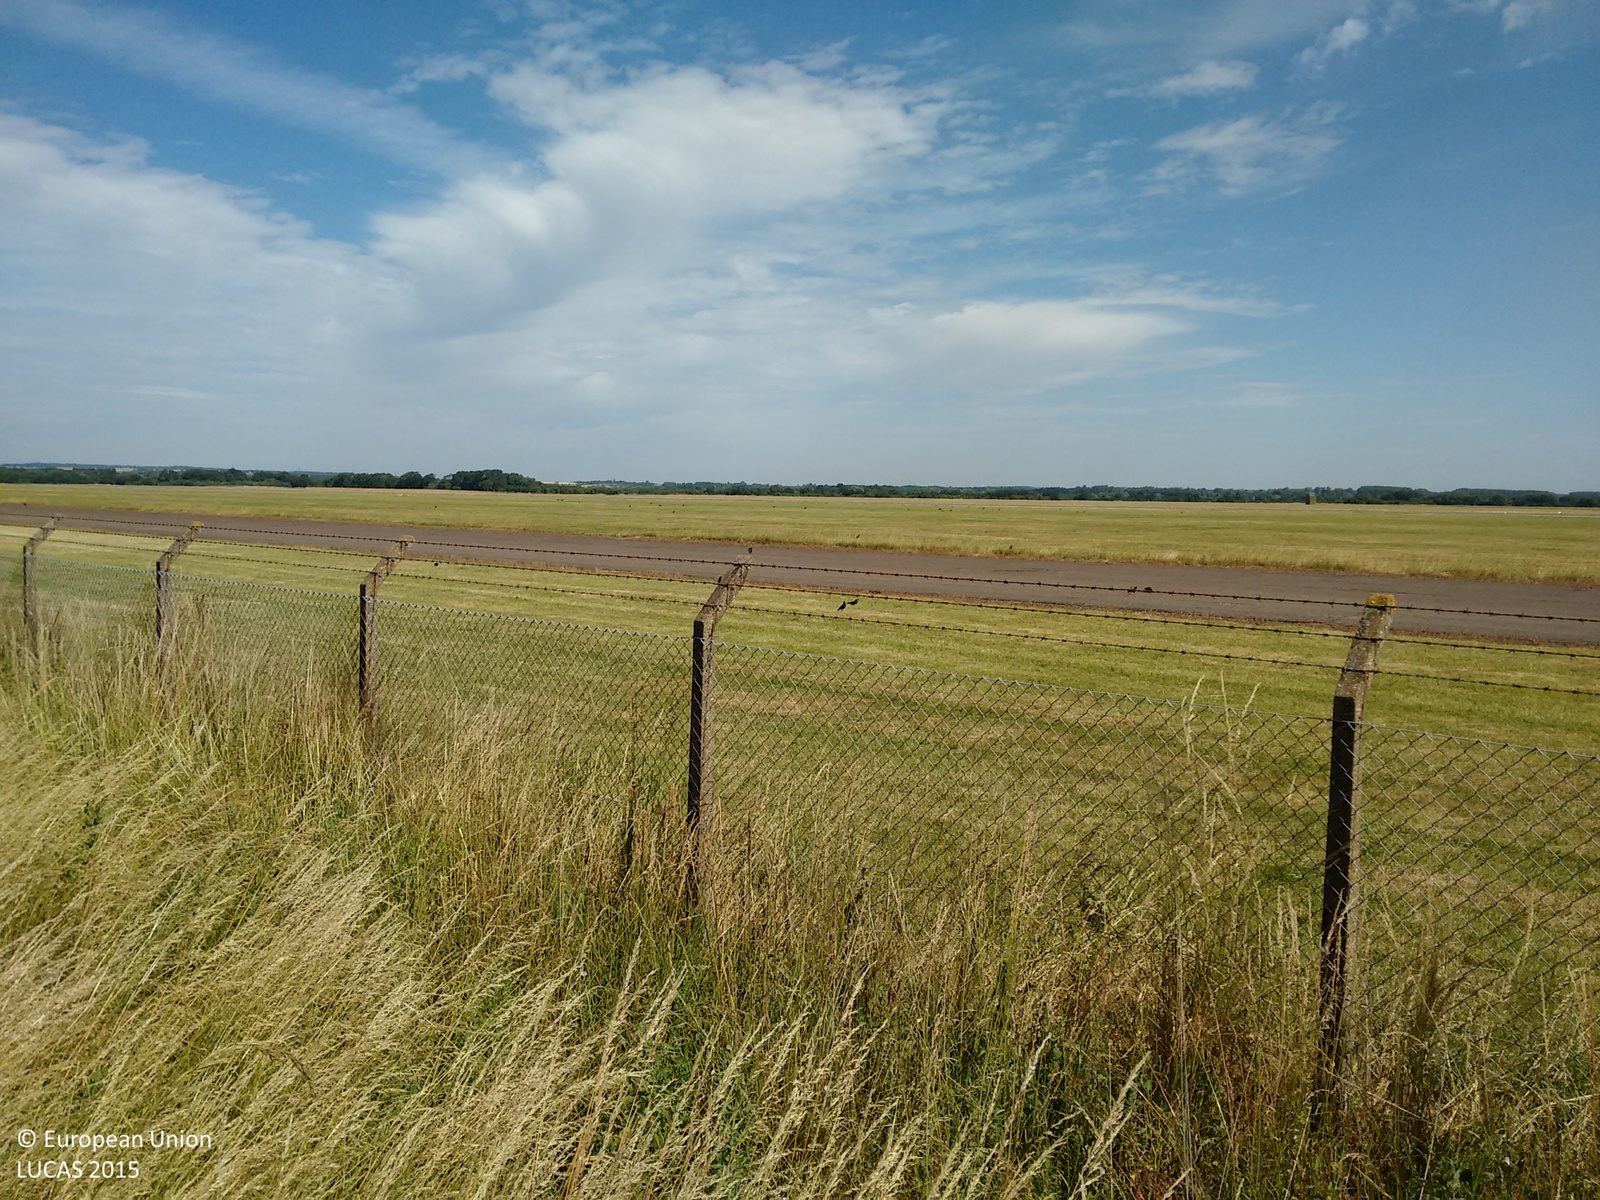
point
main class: Grassland
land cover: Grassland without tree/shrub cover
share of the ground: > 75 %
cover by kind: herbaceous plants 100 %
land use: Air transport
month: July
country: GB
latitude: 51.6755
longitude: -1.0794
